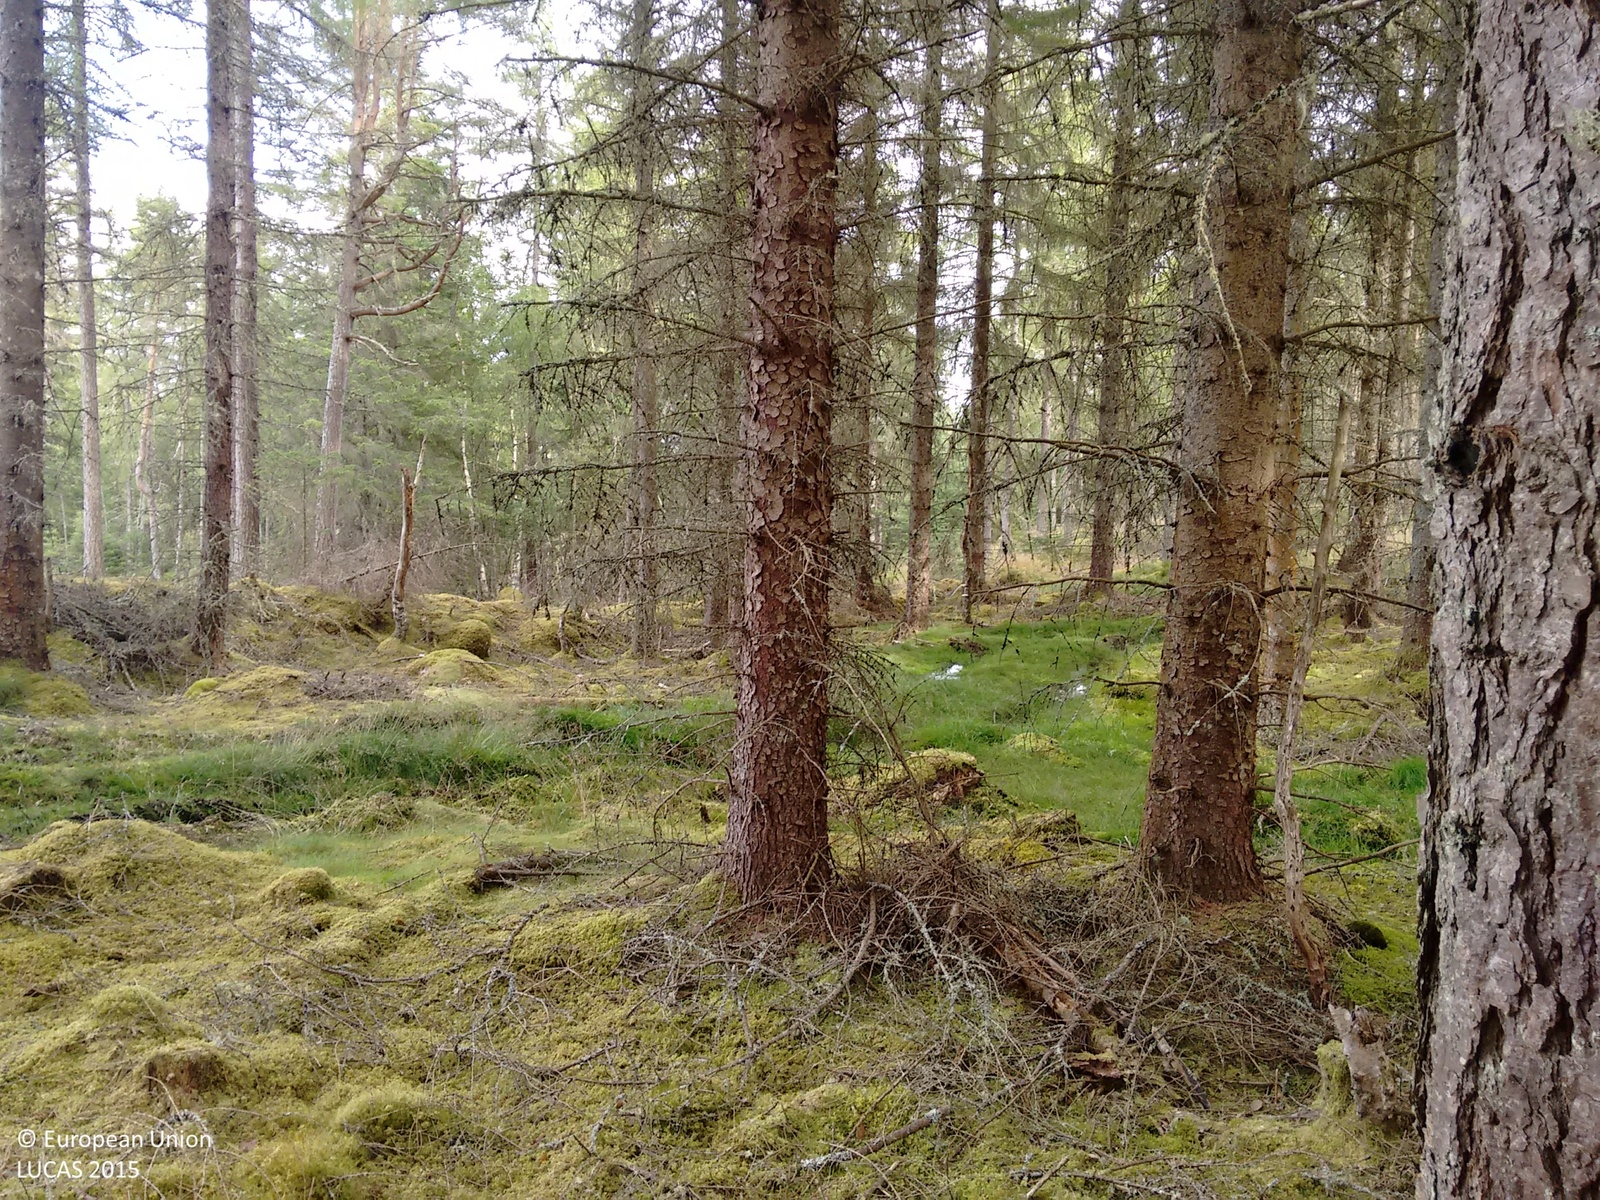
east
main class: Woodland
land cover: Spruce dominated coniferous woodland
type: exotic forest
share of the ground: > 75 %
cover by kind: coniferous forest trees 100 %
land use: Forestry
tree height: > 5 m
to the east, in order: Spruce dominated coniferous woodland; Dry stone walls; Spruce dominated coniferous woodland; Tracks; Spruce dominated mixed woodland; Other bare soil; Spruce dominated coniferous woodland
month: September
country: GB
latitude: 57.5714
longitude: -4.5204
